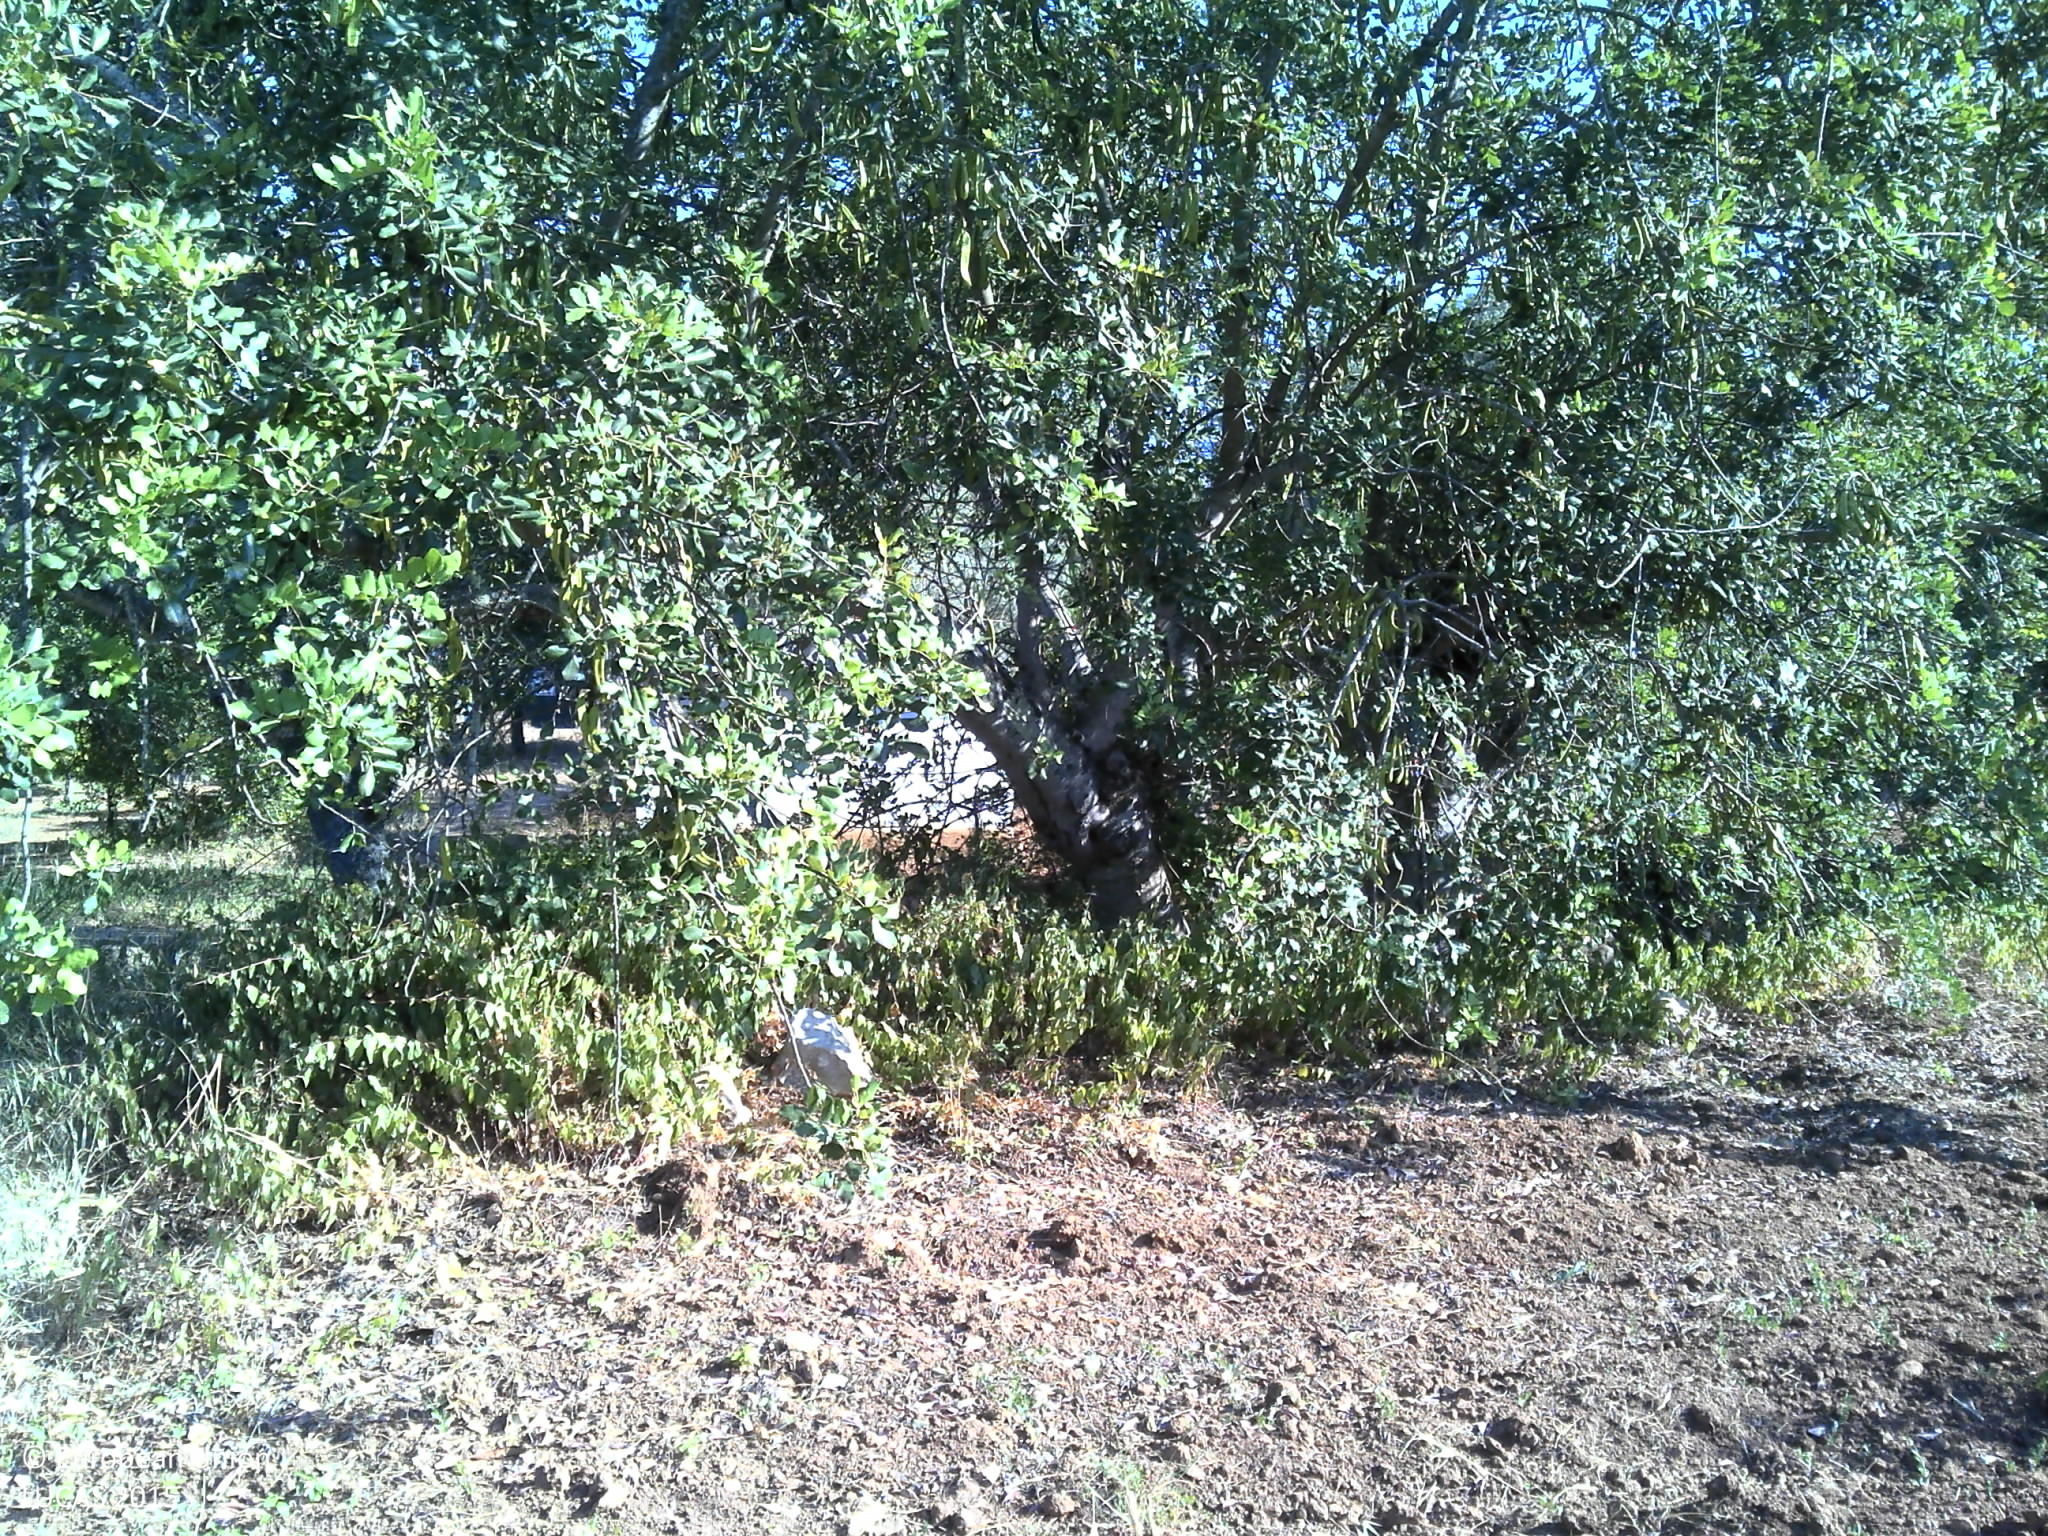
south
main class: Cropland
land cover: Permanent industrial crops
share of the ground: < 10 %
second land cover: Other bare soil
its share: > 75 %
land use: Agriculture (excluding fallow land and kitchen gardens)
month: June
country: PT
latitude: 37.0996
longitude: -7.7503
